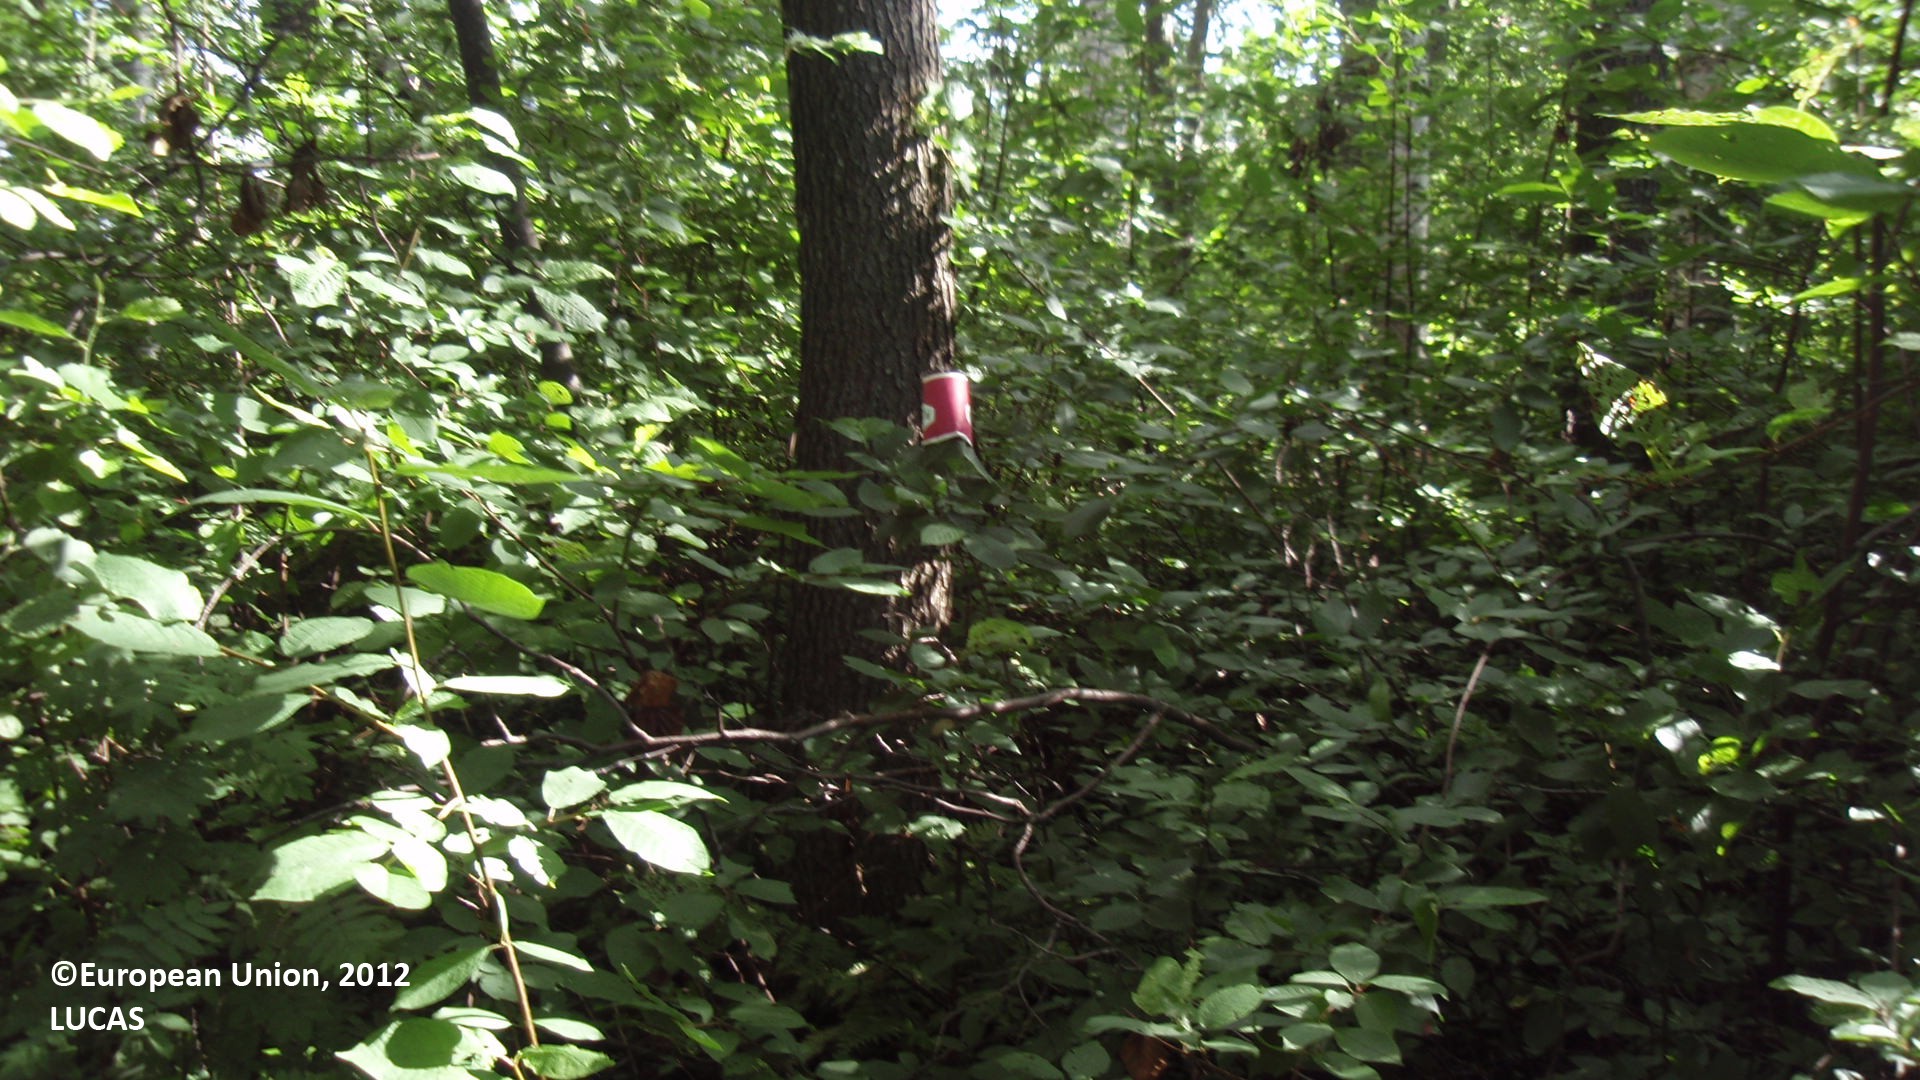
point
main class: Woodland
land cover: Broadleaved woodland
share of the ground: 50 - 75 %
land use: Forestry
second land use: Amenities, museums, leisure
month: July
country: FI
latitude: 61.2320
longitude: 28.8739
